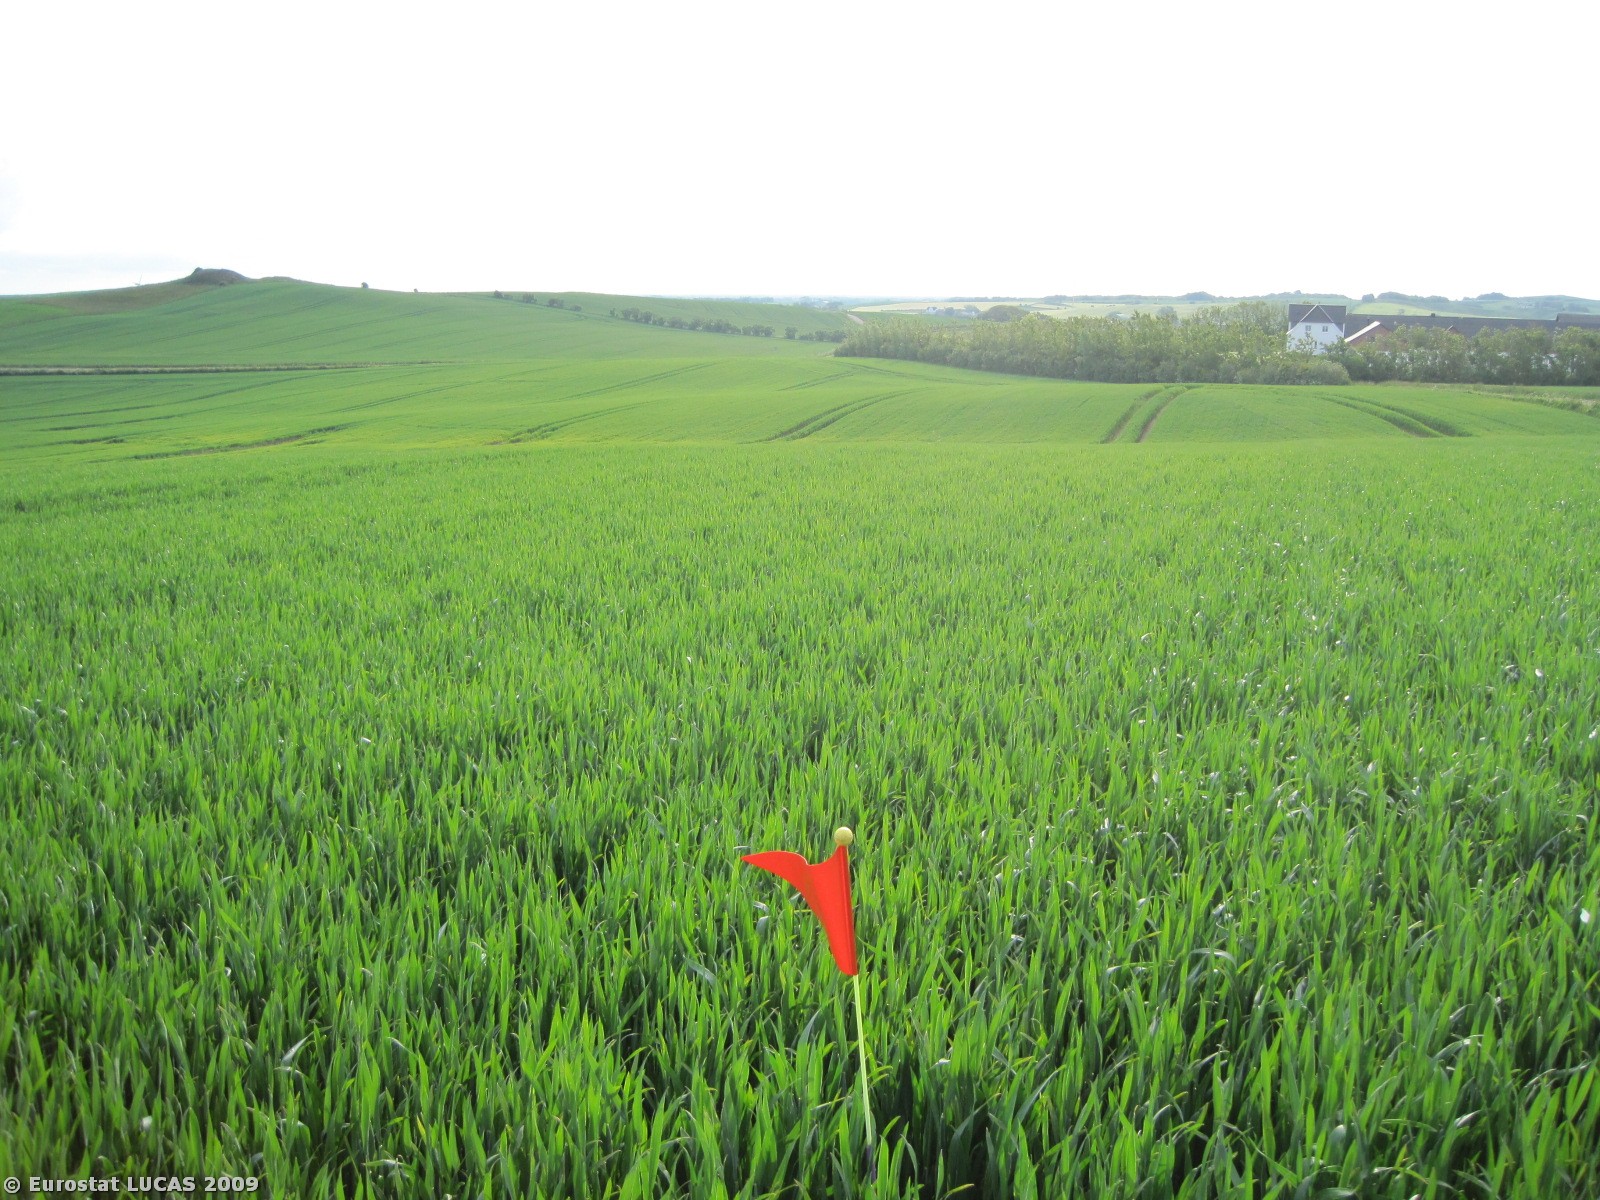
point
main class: Cropland
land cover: Common wheat
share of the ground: > 75 %
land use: Agriculture (excluding fallow land and kitchen gardens)
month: June
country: DK
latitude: 57.5361
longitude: 9.9833
